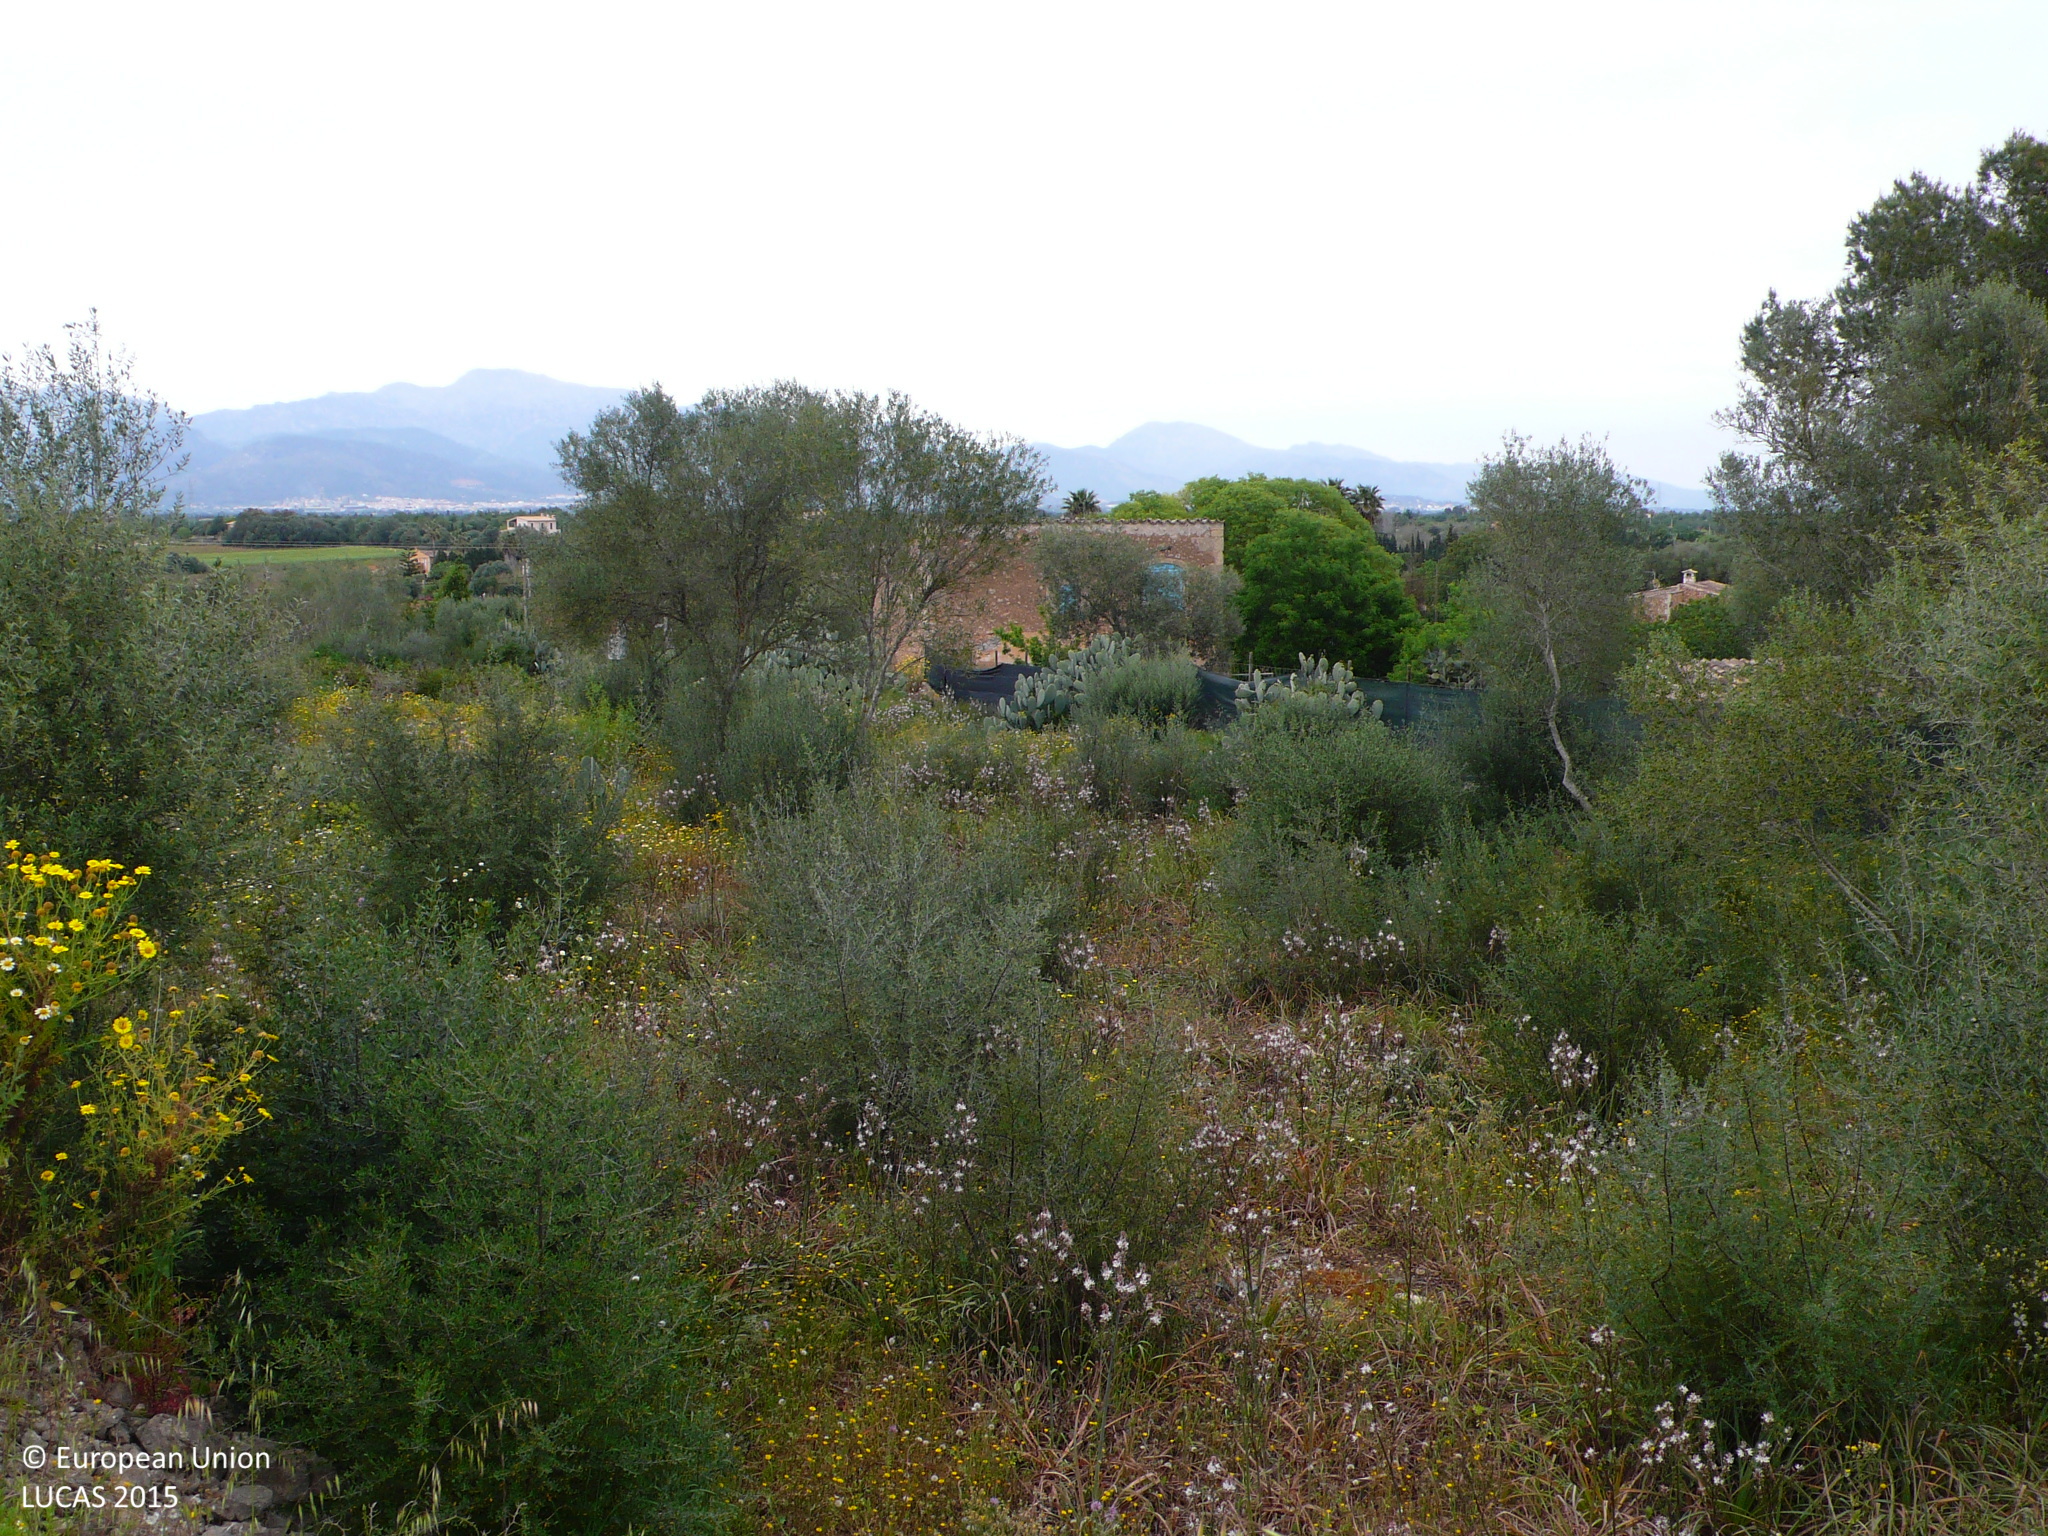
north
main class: Woodland
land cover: Broadleaved woodland
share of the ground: 25 - 50 %
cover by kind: broadleaved forest trees 40 %, shrubs 35 %, herbaceous plants 15 %, unconsolidated bare surface 10 %
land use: Abandoned areas
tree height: < 5 m
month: April
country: ES
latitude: 39.6455
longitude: 2.8864
